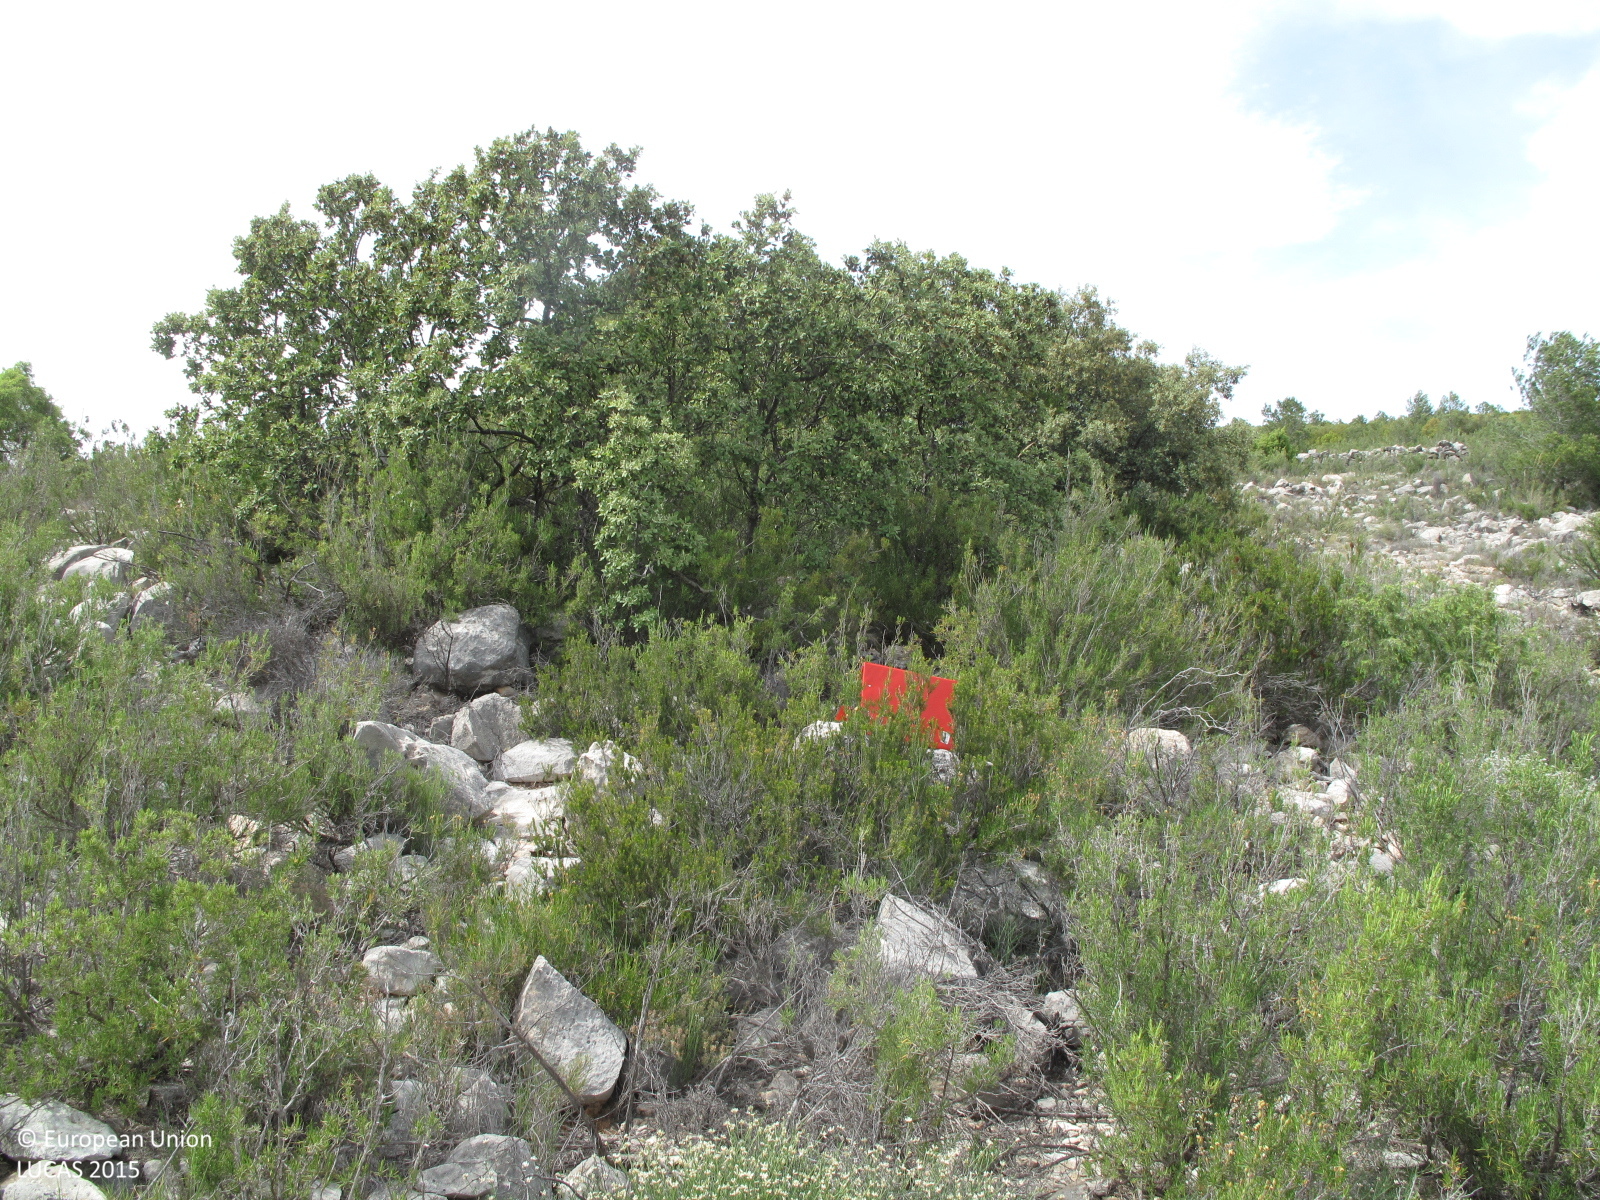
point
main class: Shrubland
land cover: Shrubland with sparse tree cover
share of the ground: 25 - 50 %
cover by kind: consolidated bare surface 50 %, shrubs 25 %, herbaceous plants 20 %, broadleaved forest trees 5 %
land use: Semi-natural and natural areas not in use
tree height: < 5 m
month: May
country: ES
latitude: 38.8212
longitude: -0.7147
